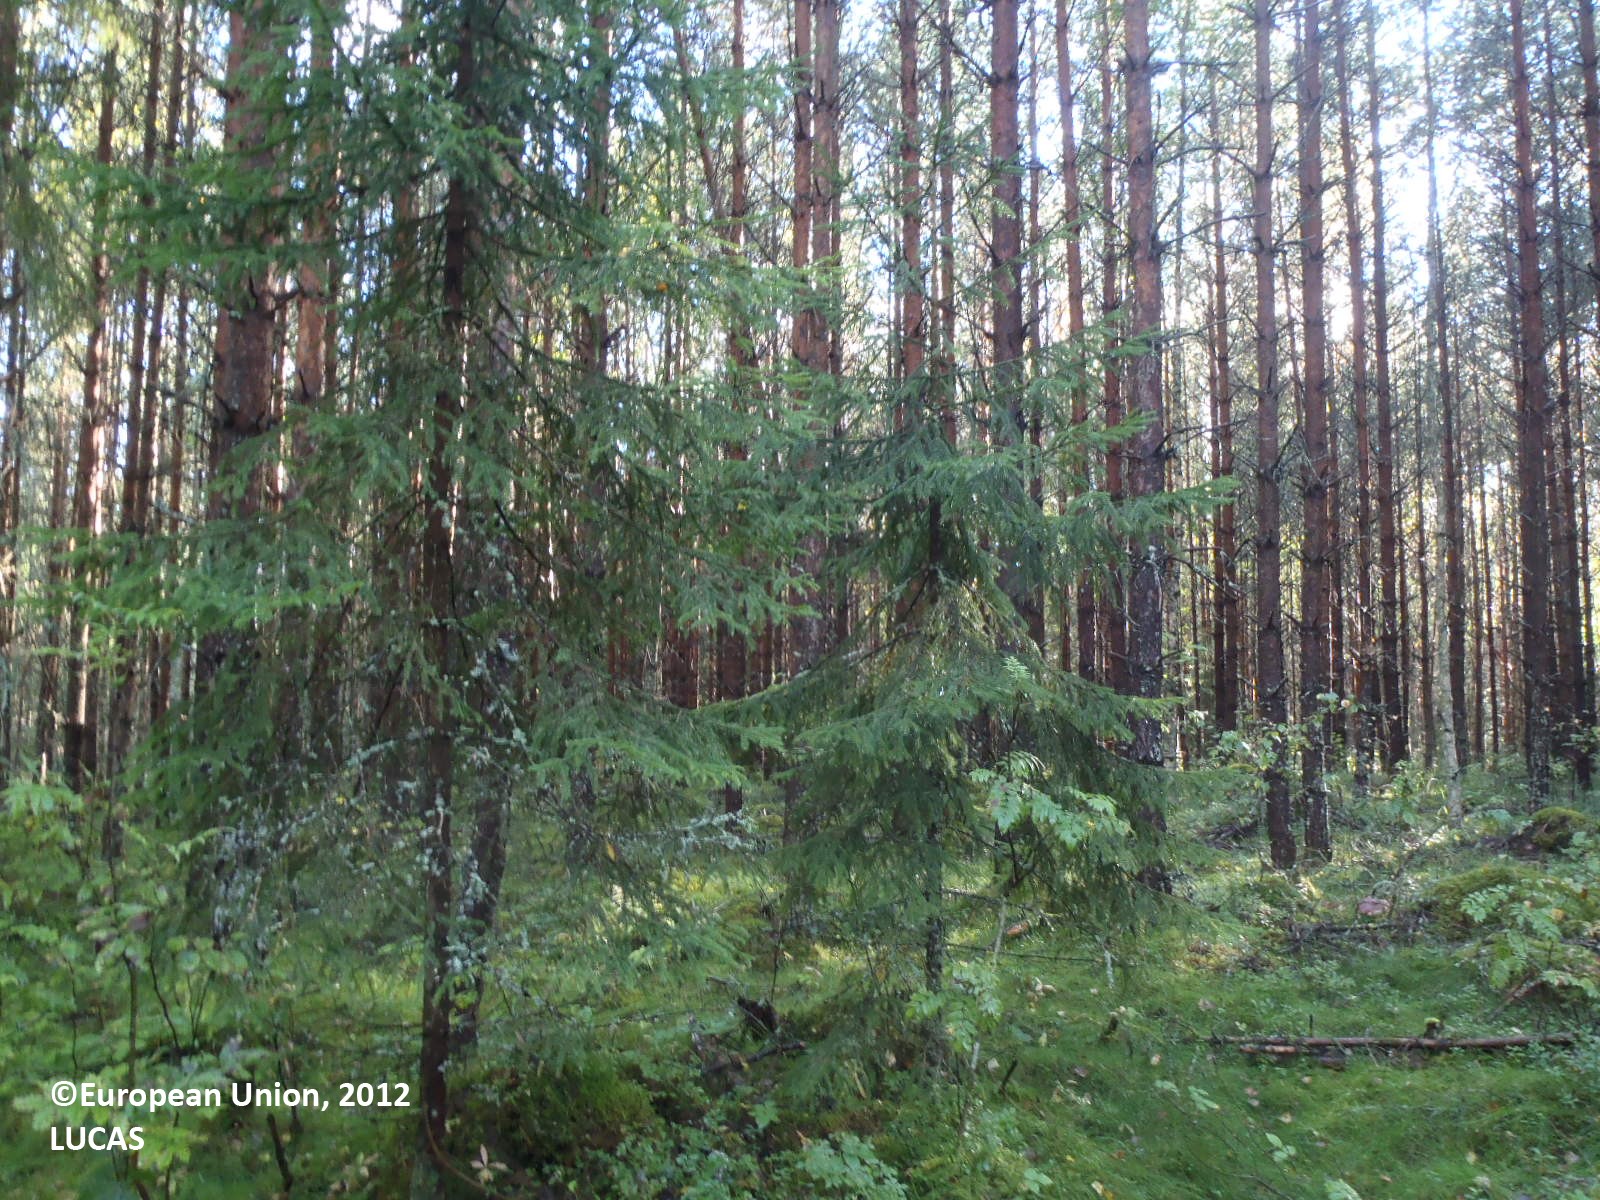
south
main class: Woodland
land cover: Pine dominated mixed woodland
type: boreal forest
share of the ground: > 75 %
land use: Forestry
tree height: > 5 m
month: September
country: FI
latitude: 61.0909
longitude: 22.6223
